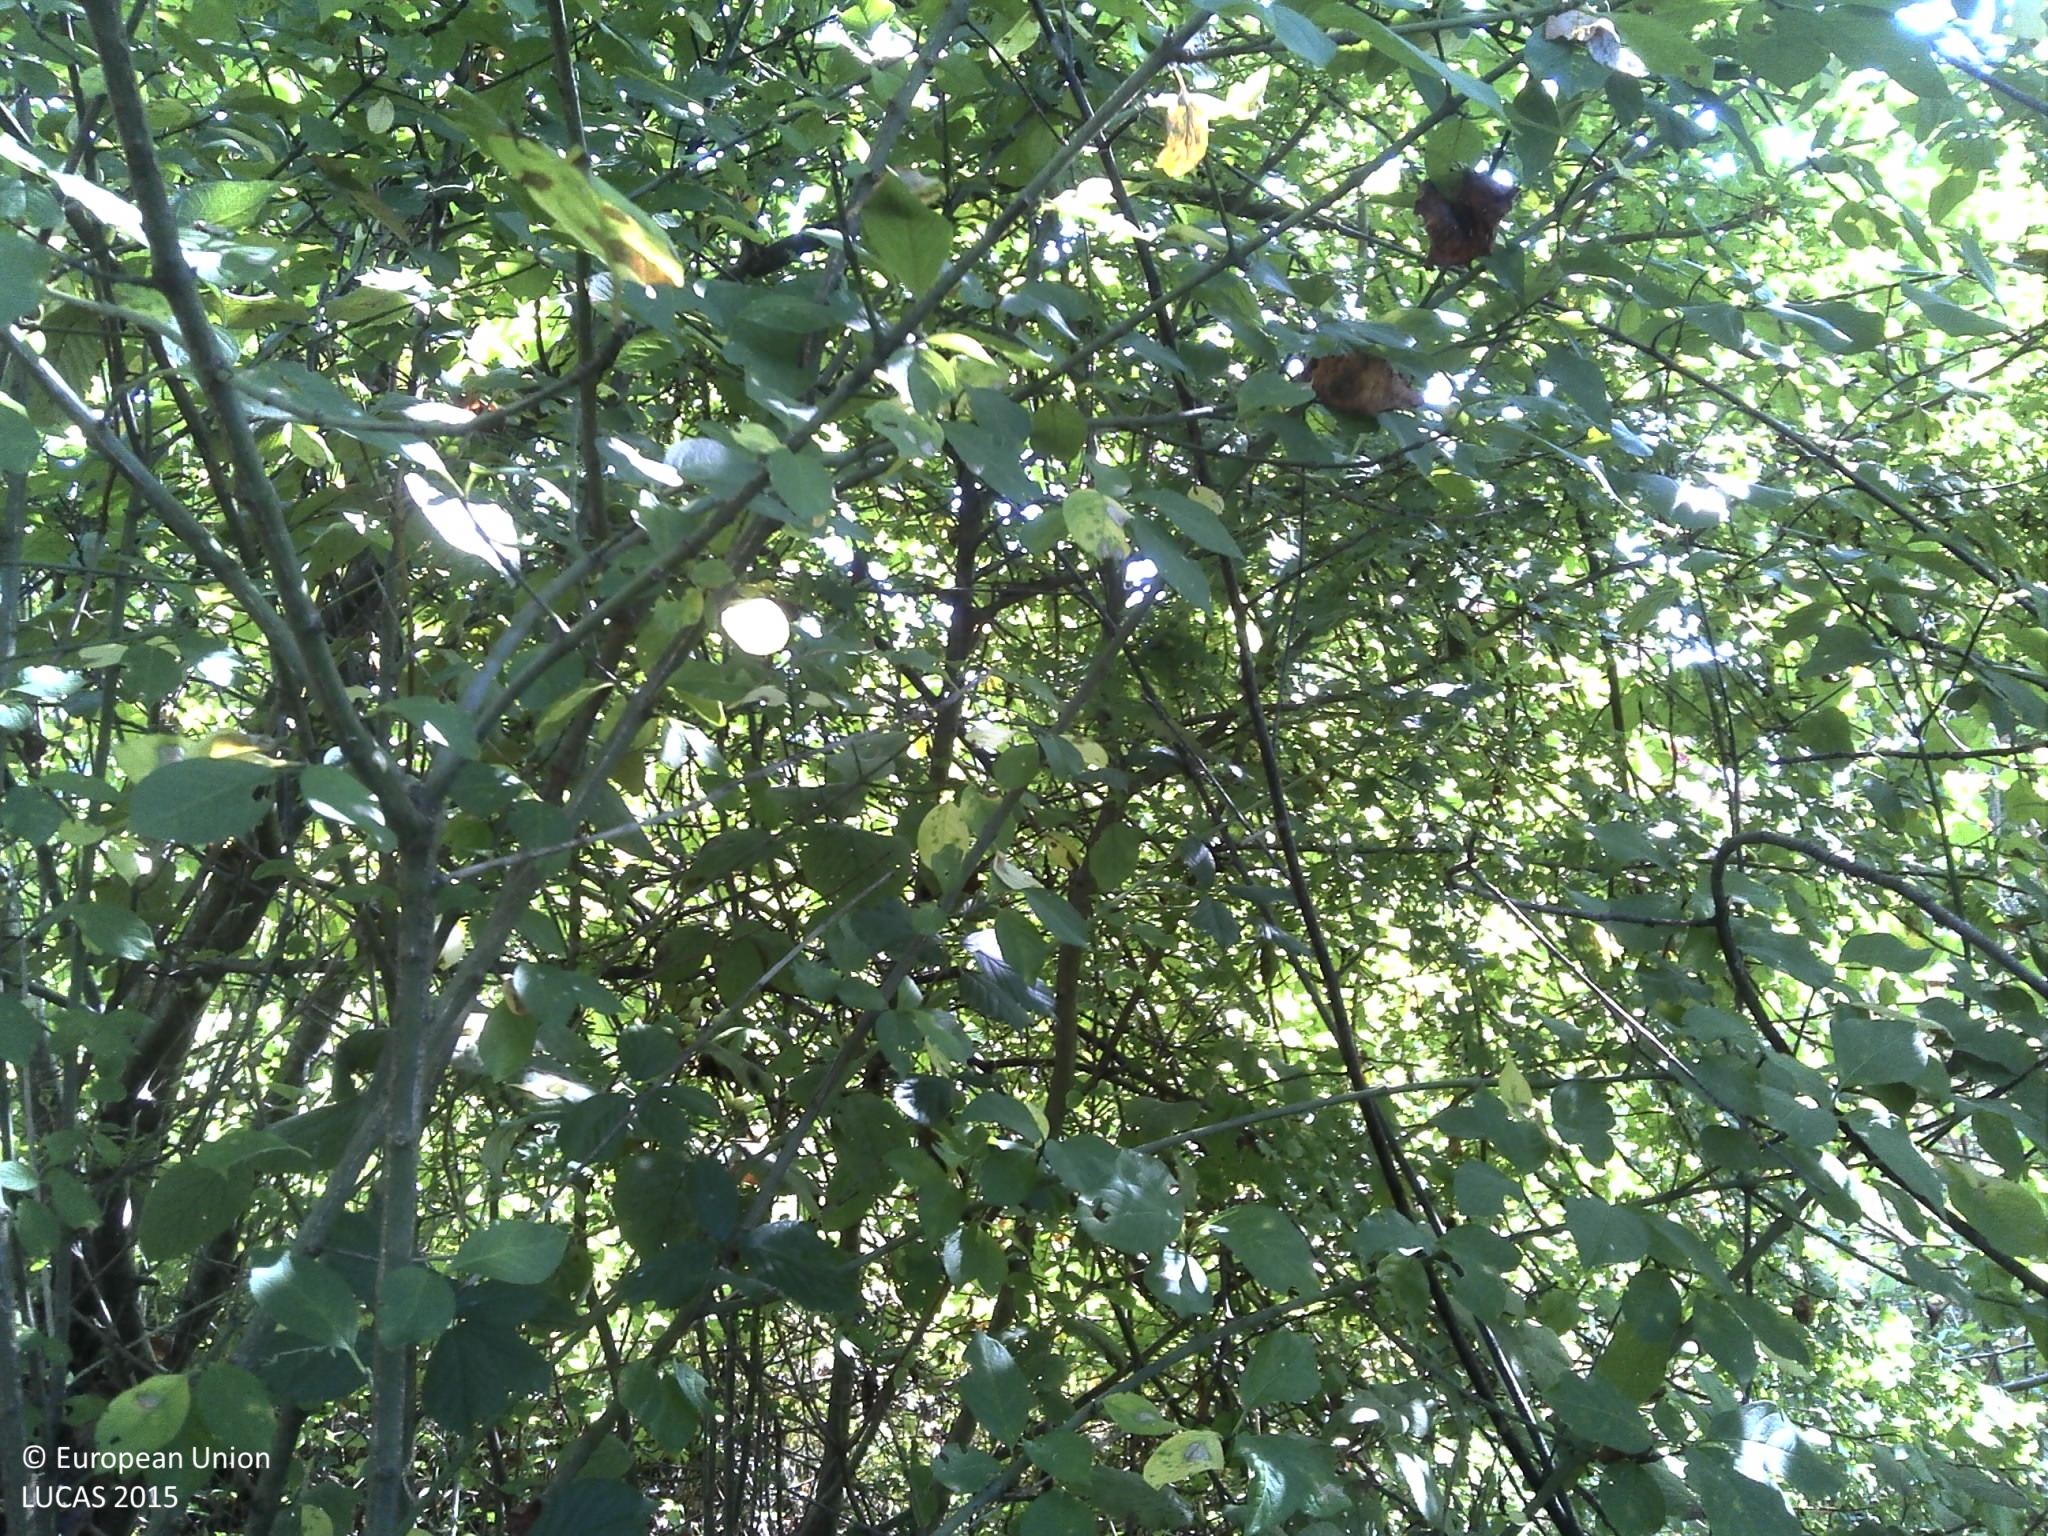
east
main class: Woodland
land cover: Broadleaved woodland
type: acidophilous oak and oak-birch forest
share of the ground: > 75 %
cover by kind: broadleaved forest trees 95 %, shrubs 5 %
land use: Semi-natural and natural areas not in use
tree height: > 5 m
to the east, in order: Broadleaved woodland; Shrubland with sparse tree cover; Tracks; Broadleaved woodland; Inland fresh running water; Broadleaved woodland; Tracks; Broadleaved woodland
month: August
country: HR
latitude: 45.0849
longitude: 15.5979
